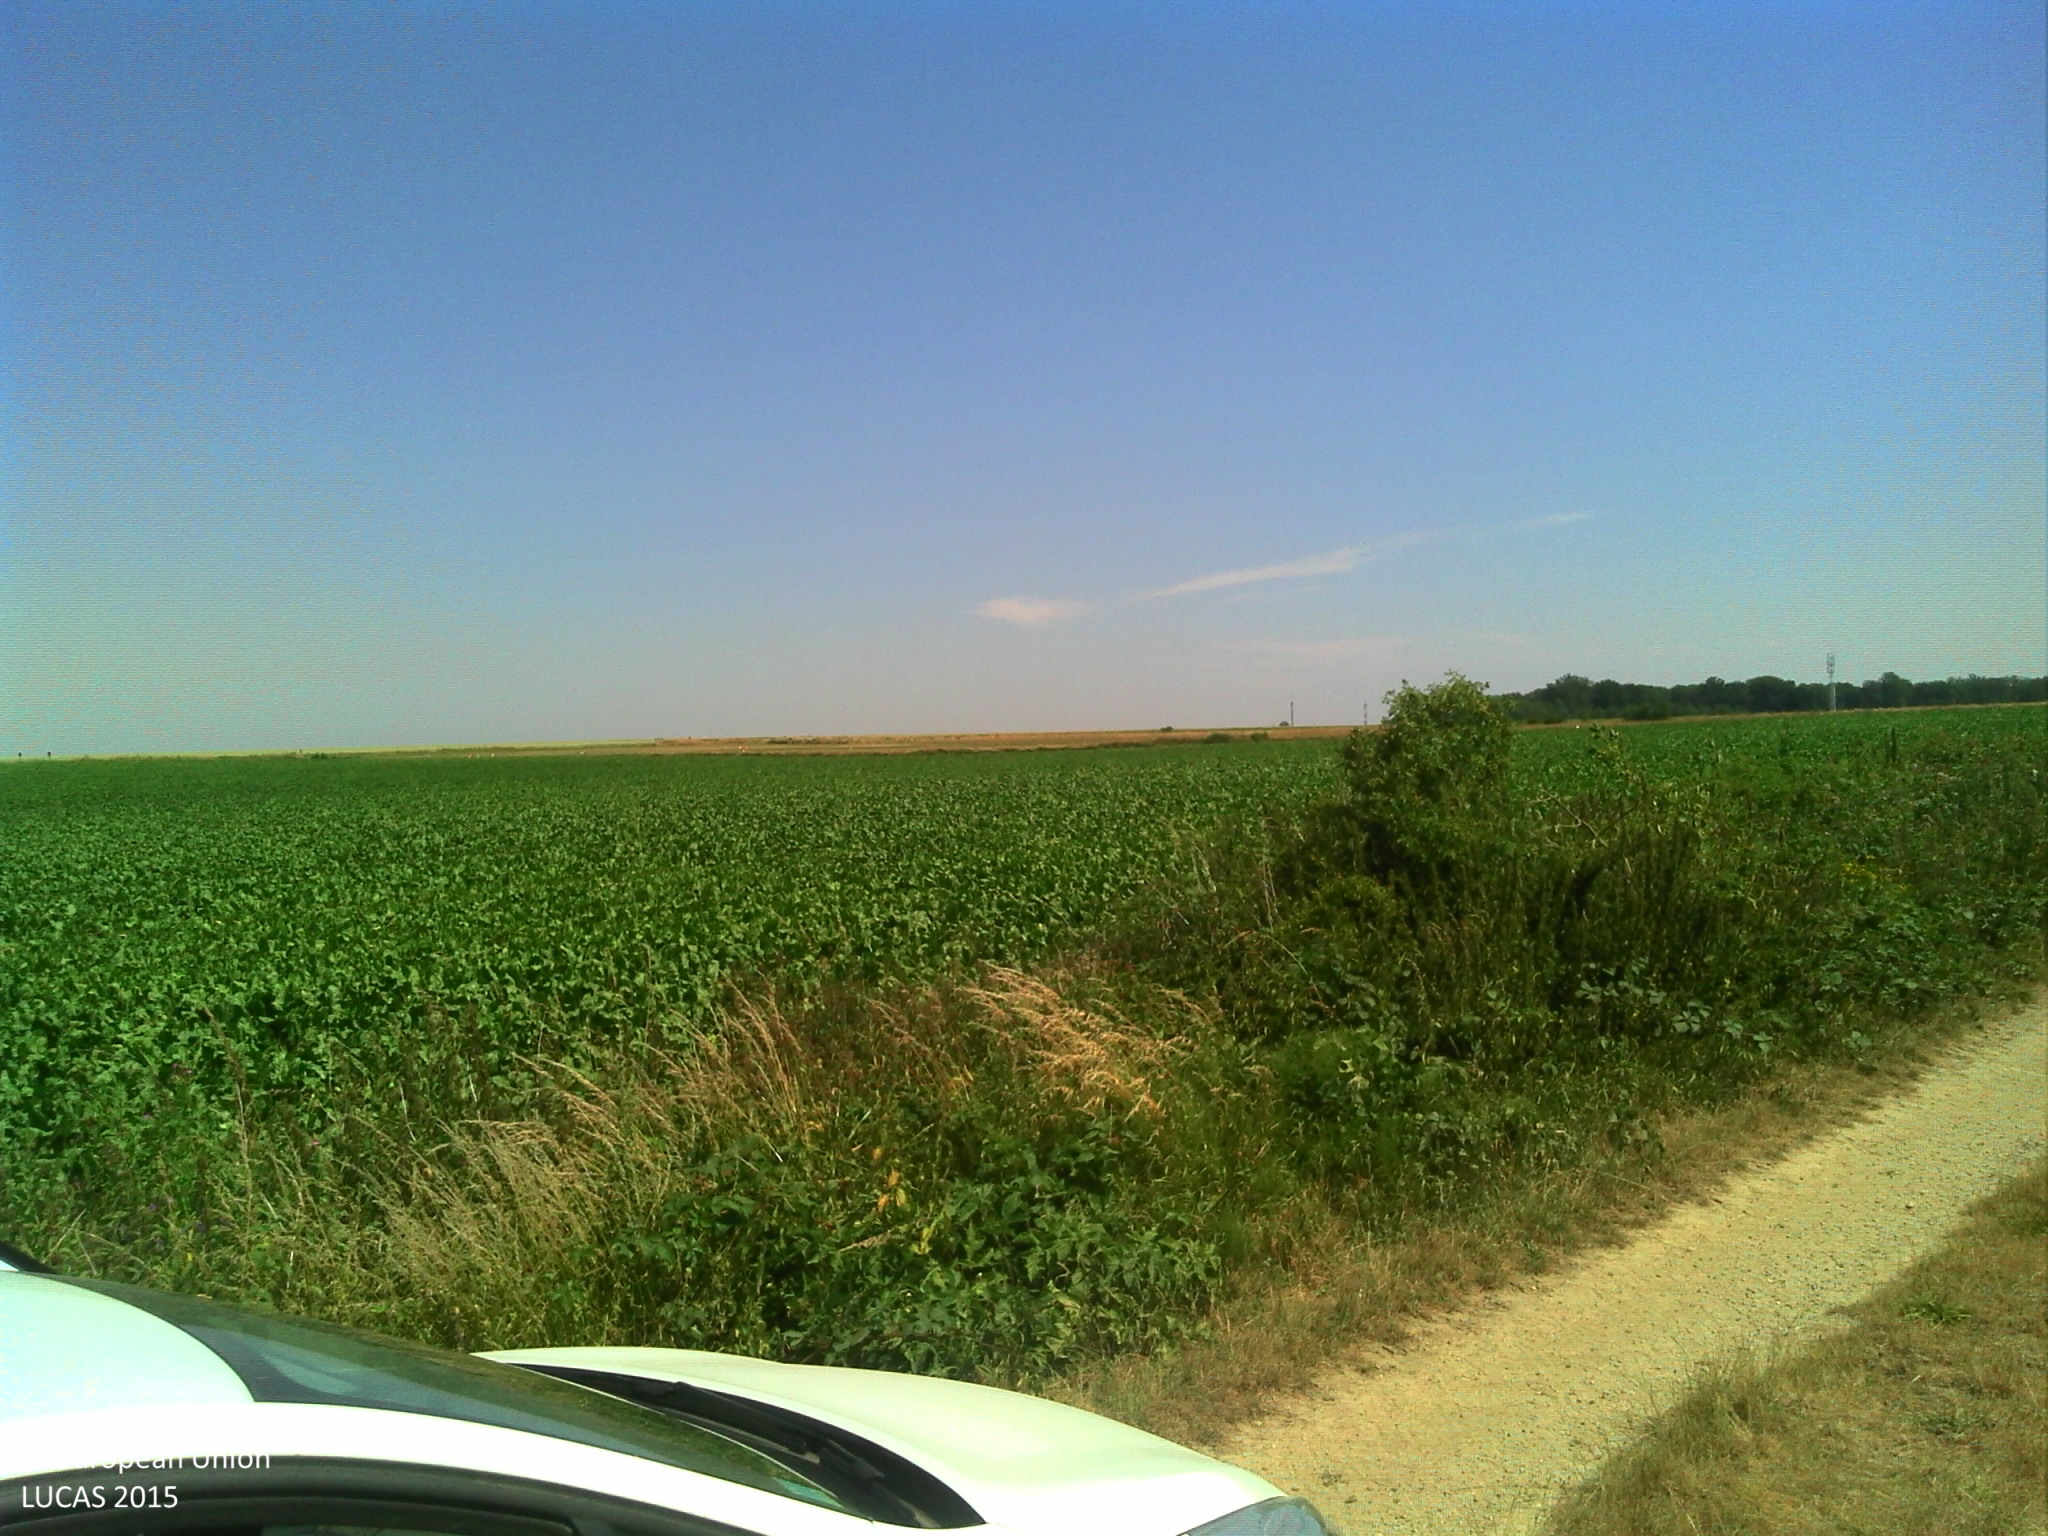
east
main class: Cropland
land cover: Rape and turnip rape
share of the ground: > 75 %
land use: Agriculture (excluding fallow land and kitchen gardens)
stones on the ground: < 10 %
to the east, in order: Rape and turnip rape; Grass margins; Tracks; Spontaneously vegetated surfaces; Ditches and canals; Sugar beet
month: July
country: FR
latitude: 49.0699
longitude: 3.3539
